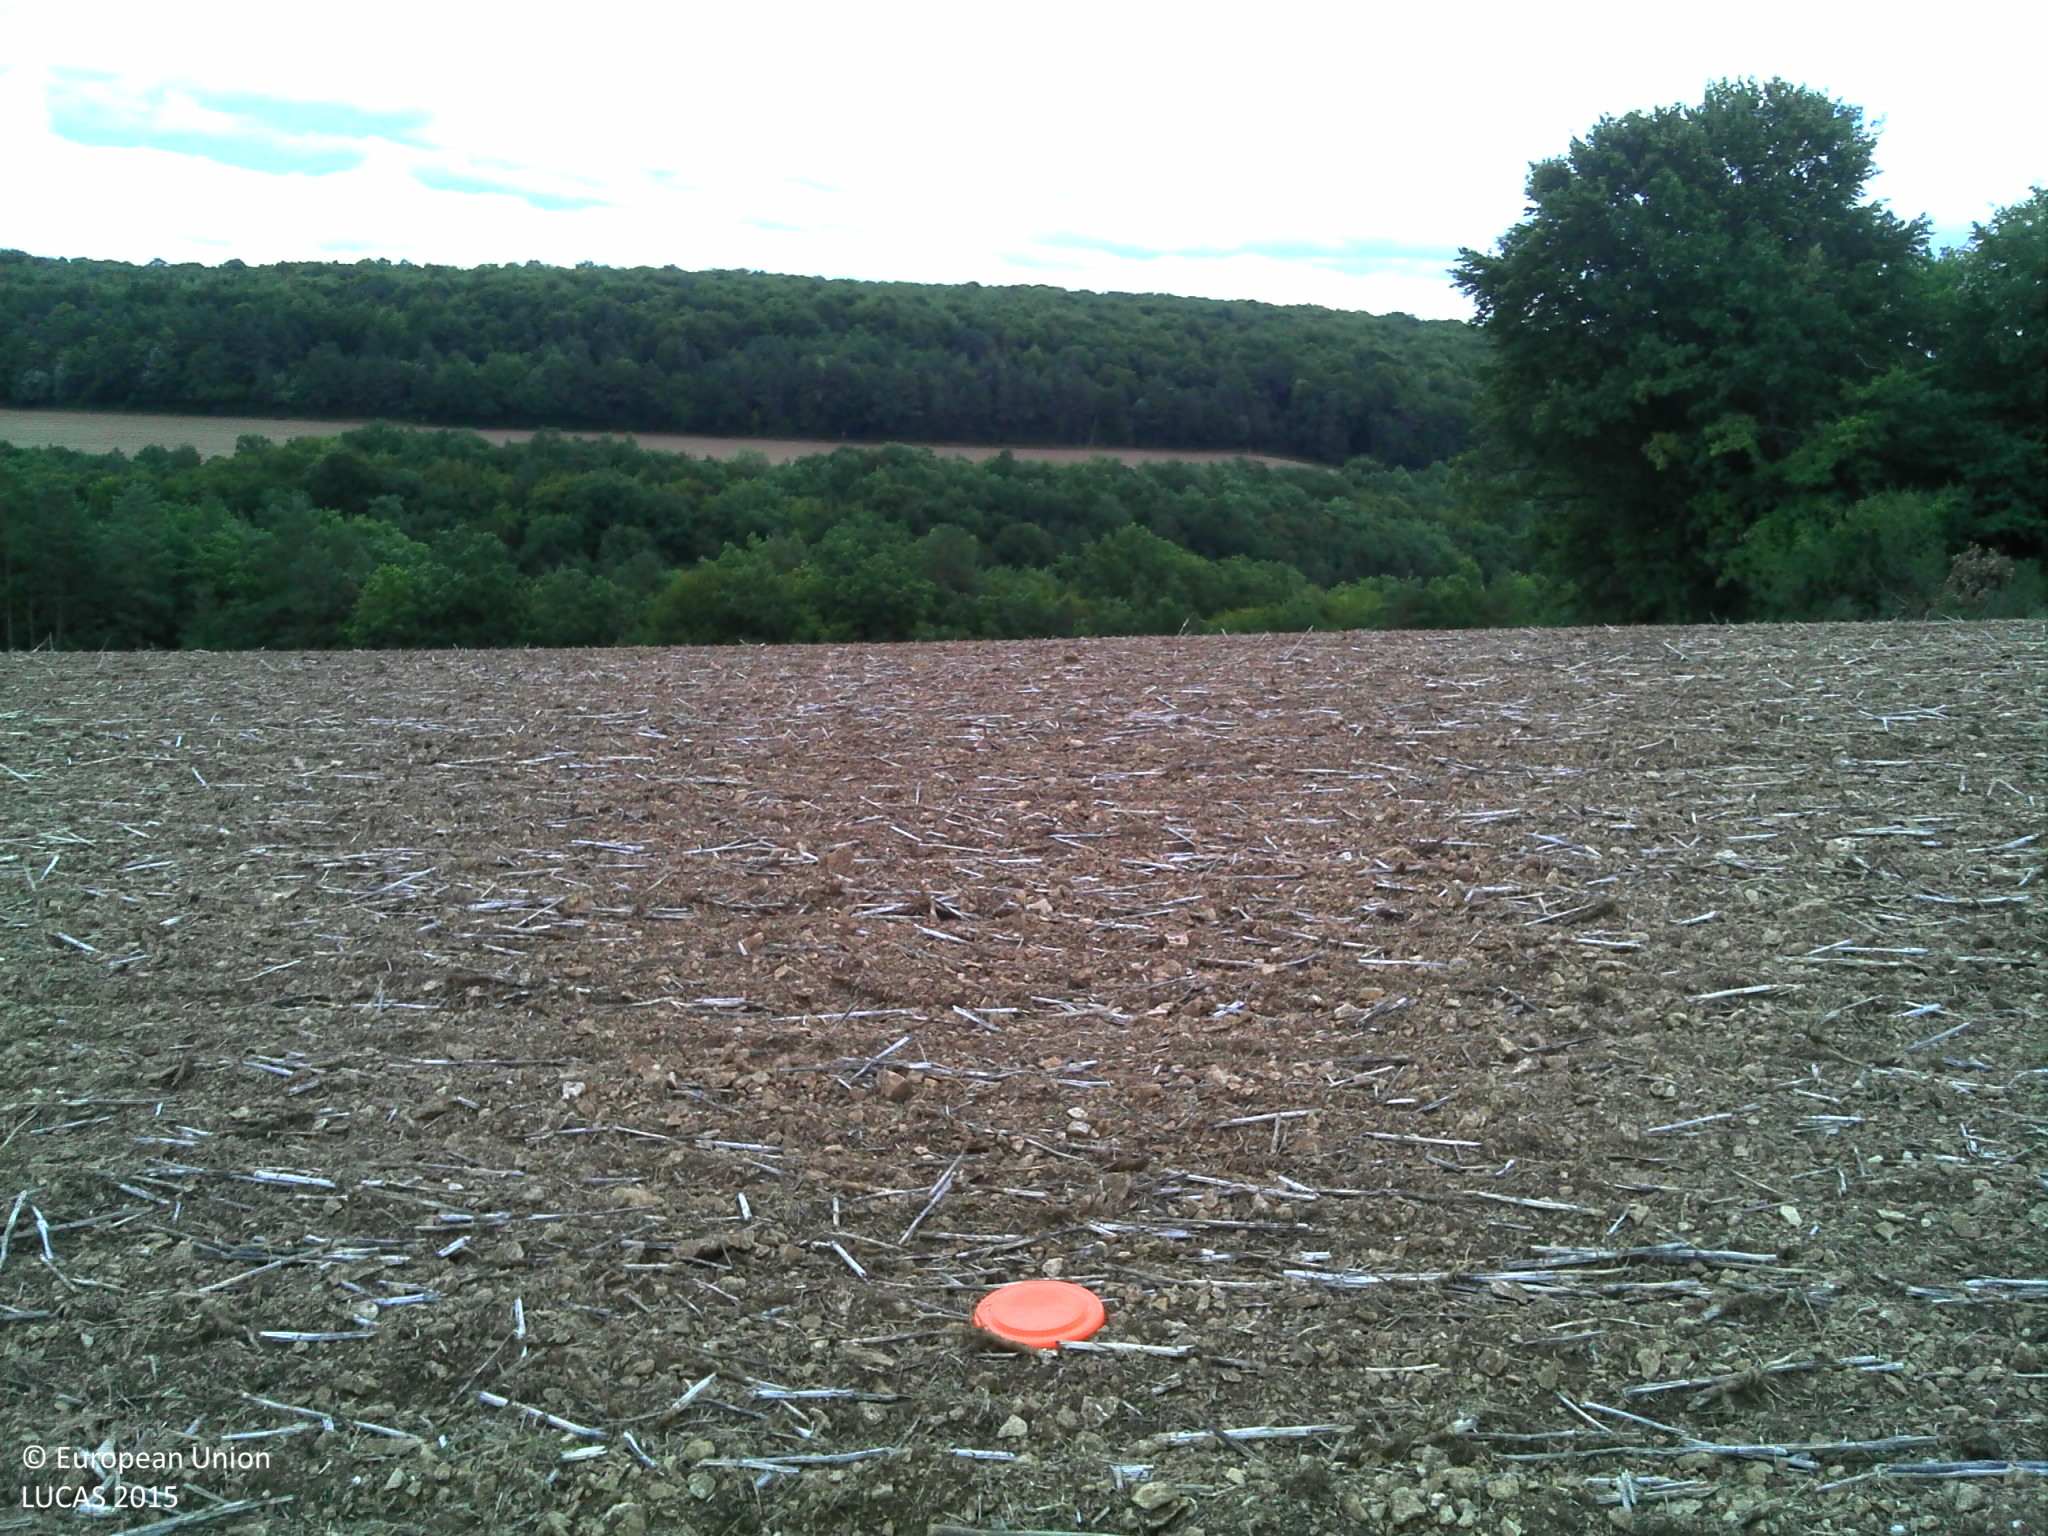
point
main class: Cropland
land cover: Rape and turnip rape
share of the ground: 25 - 50 %
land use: Agriculture (excluding fallow land and kitchen gardens)
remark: Tilled/Sowed
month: August
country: FR
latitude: 47.7215
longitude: 4.7867
